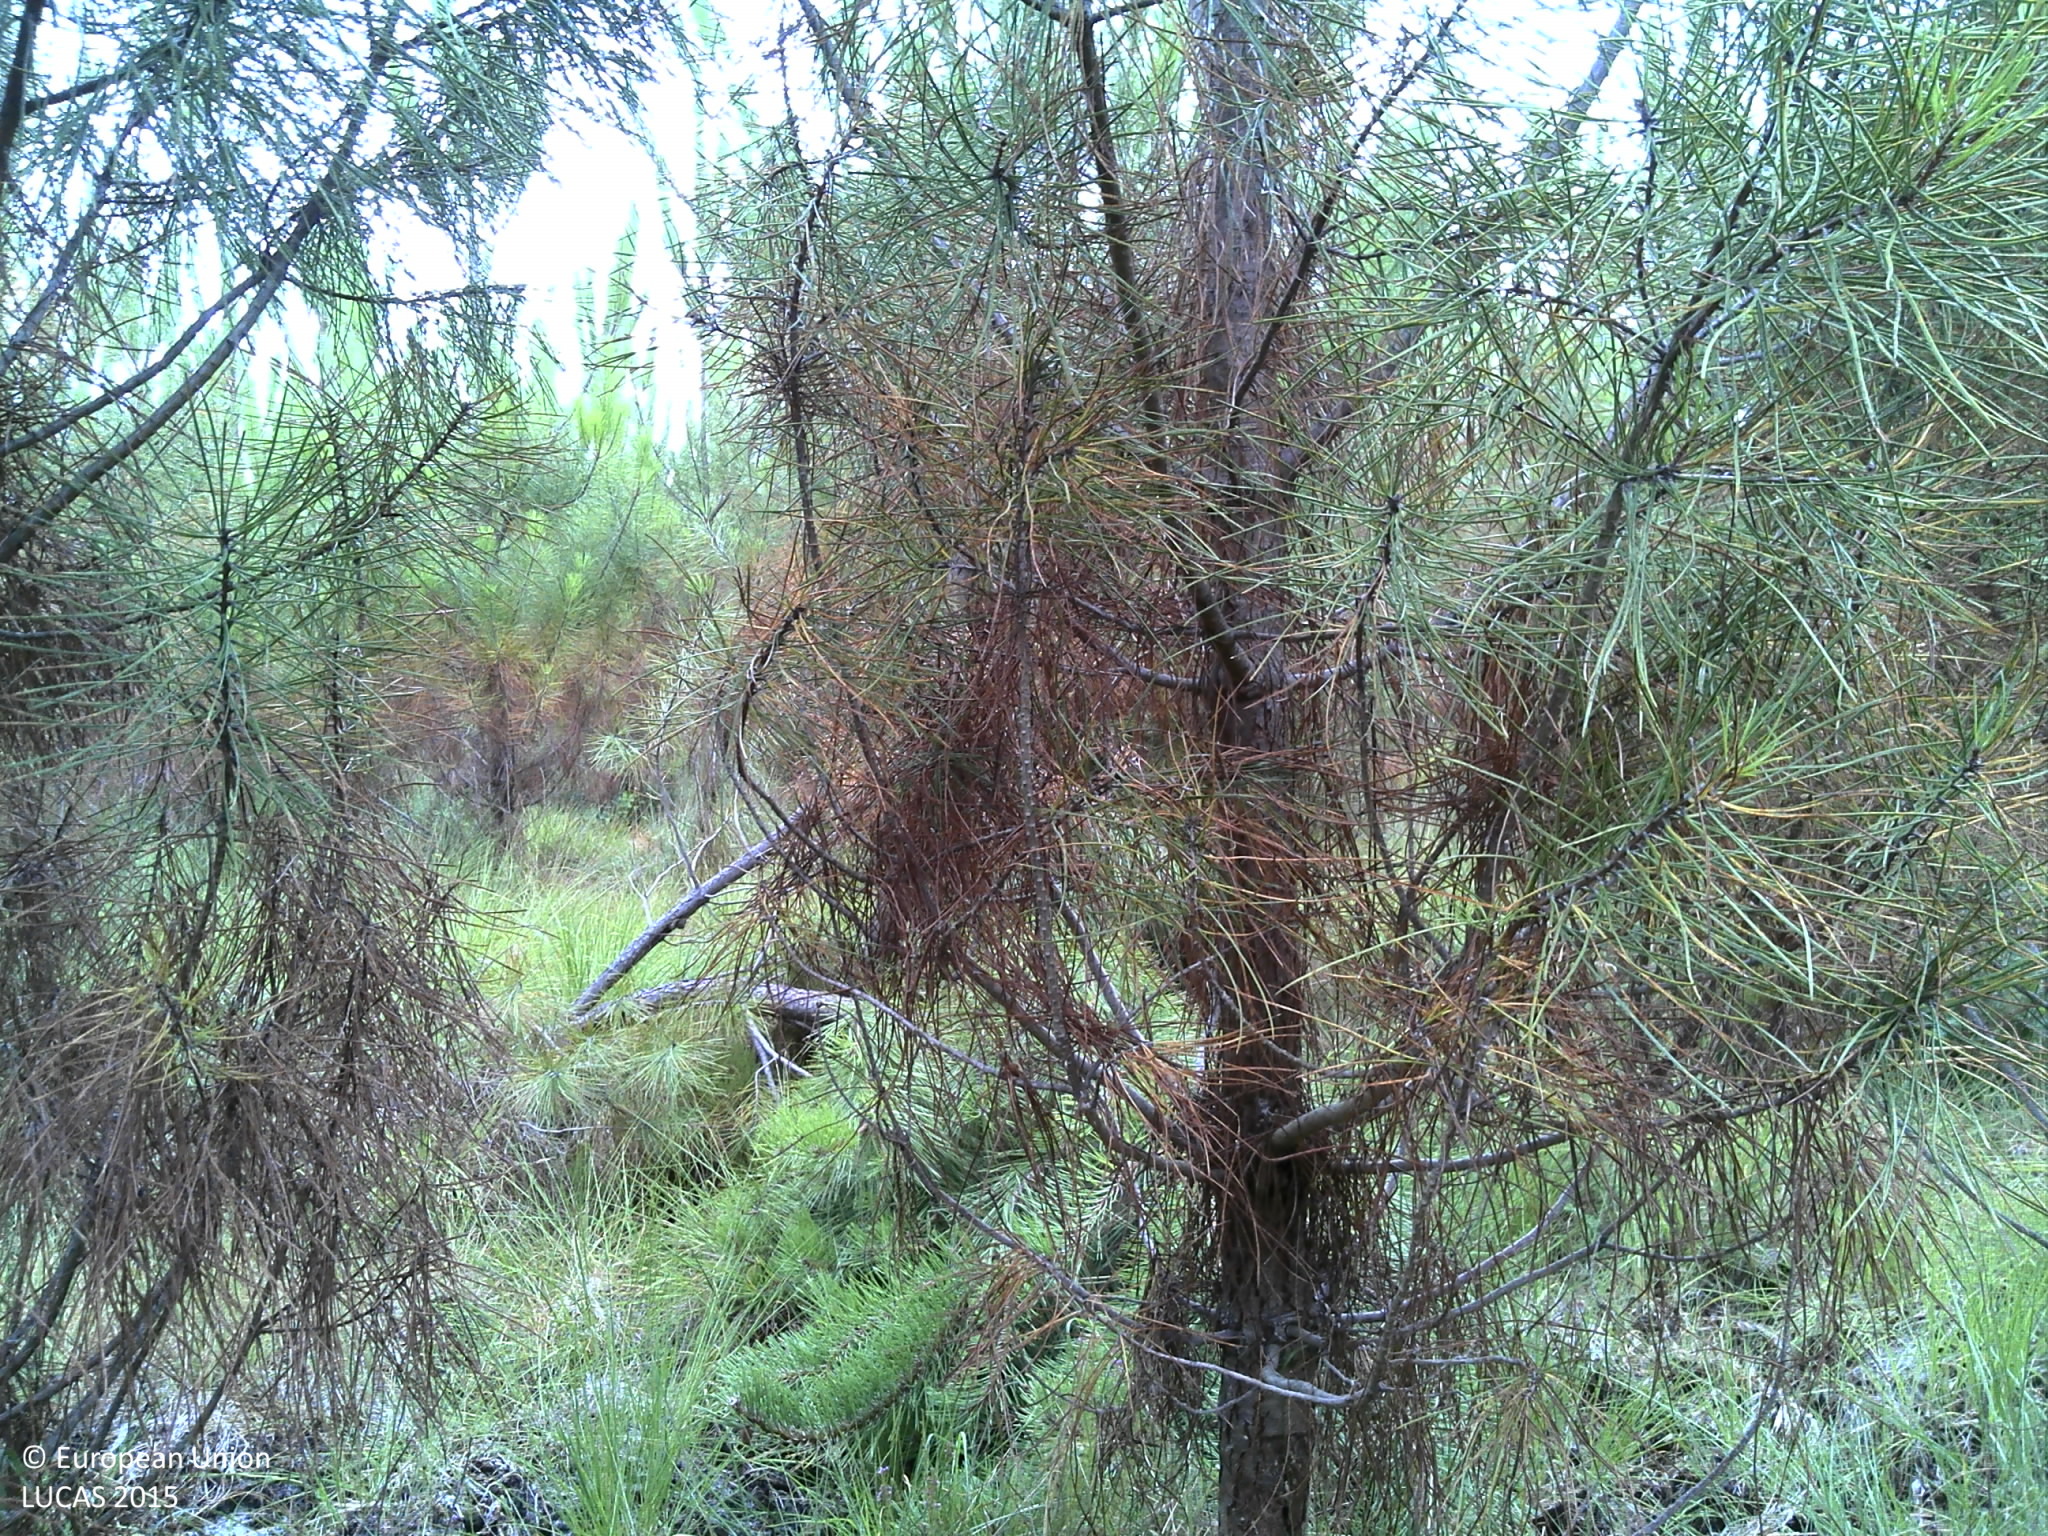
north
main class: Woodland
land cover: Pine dominated coniferous woodland
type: exotic forest
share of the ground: > 75 %
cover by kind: coniferous forest trees 60 %, shrubs 30 %, herbaceous plants 5 %, lichens and mosses 5 %
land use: Forestry
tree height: > 5 m
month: July
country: FR
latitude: 44.4408
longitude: -0.9633
